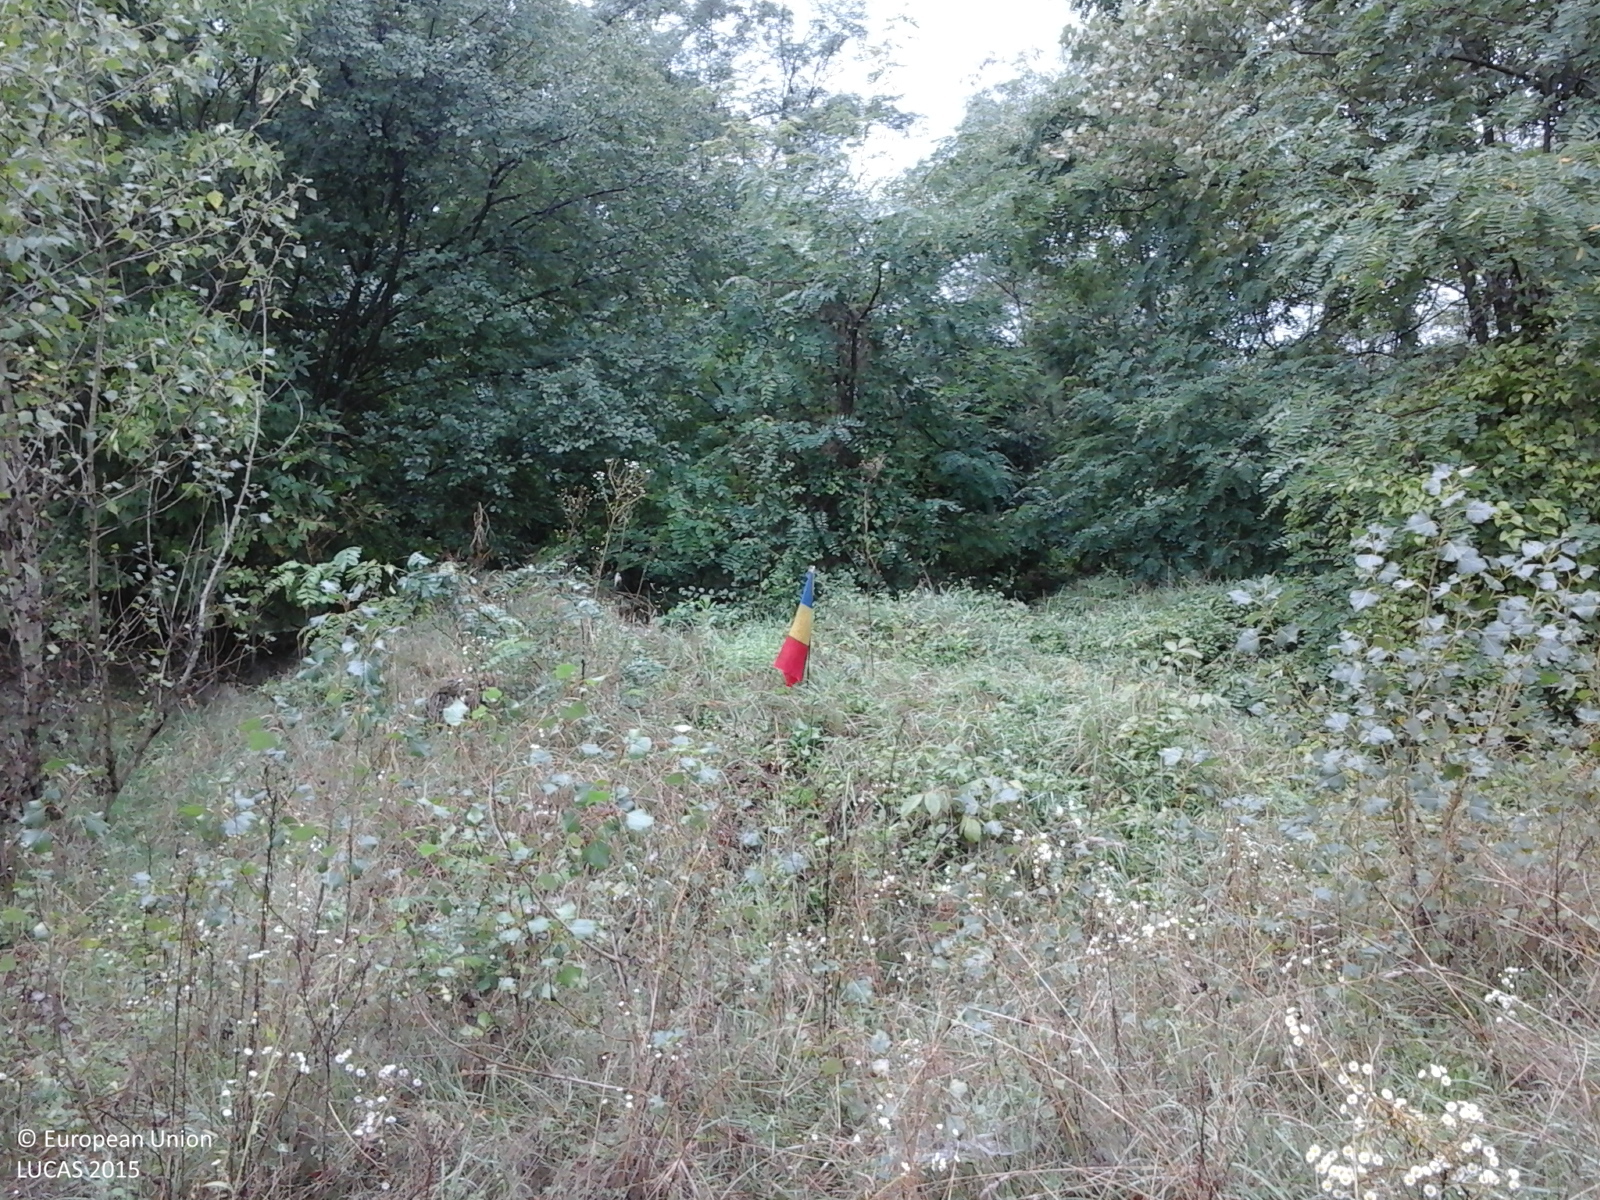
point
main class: Woodland
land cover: Broadleaved woodland
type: exotic forest
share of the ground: > 75 %
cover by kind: broadleaved forest trees 100 %
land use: Forestry
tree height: > 5 m
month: September
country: RO
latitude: 47.0157
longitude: 22.5123
